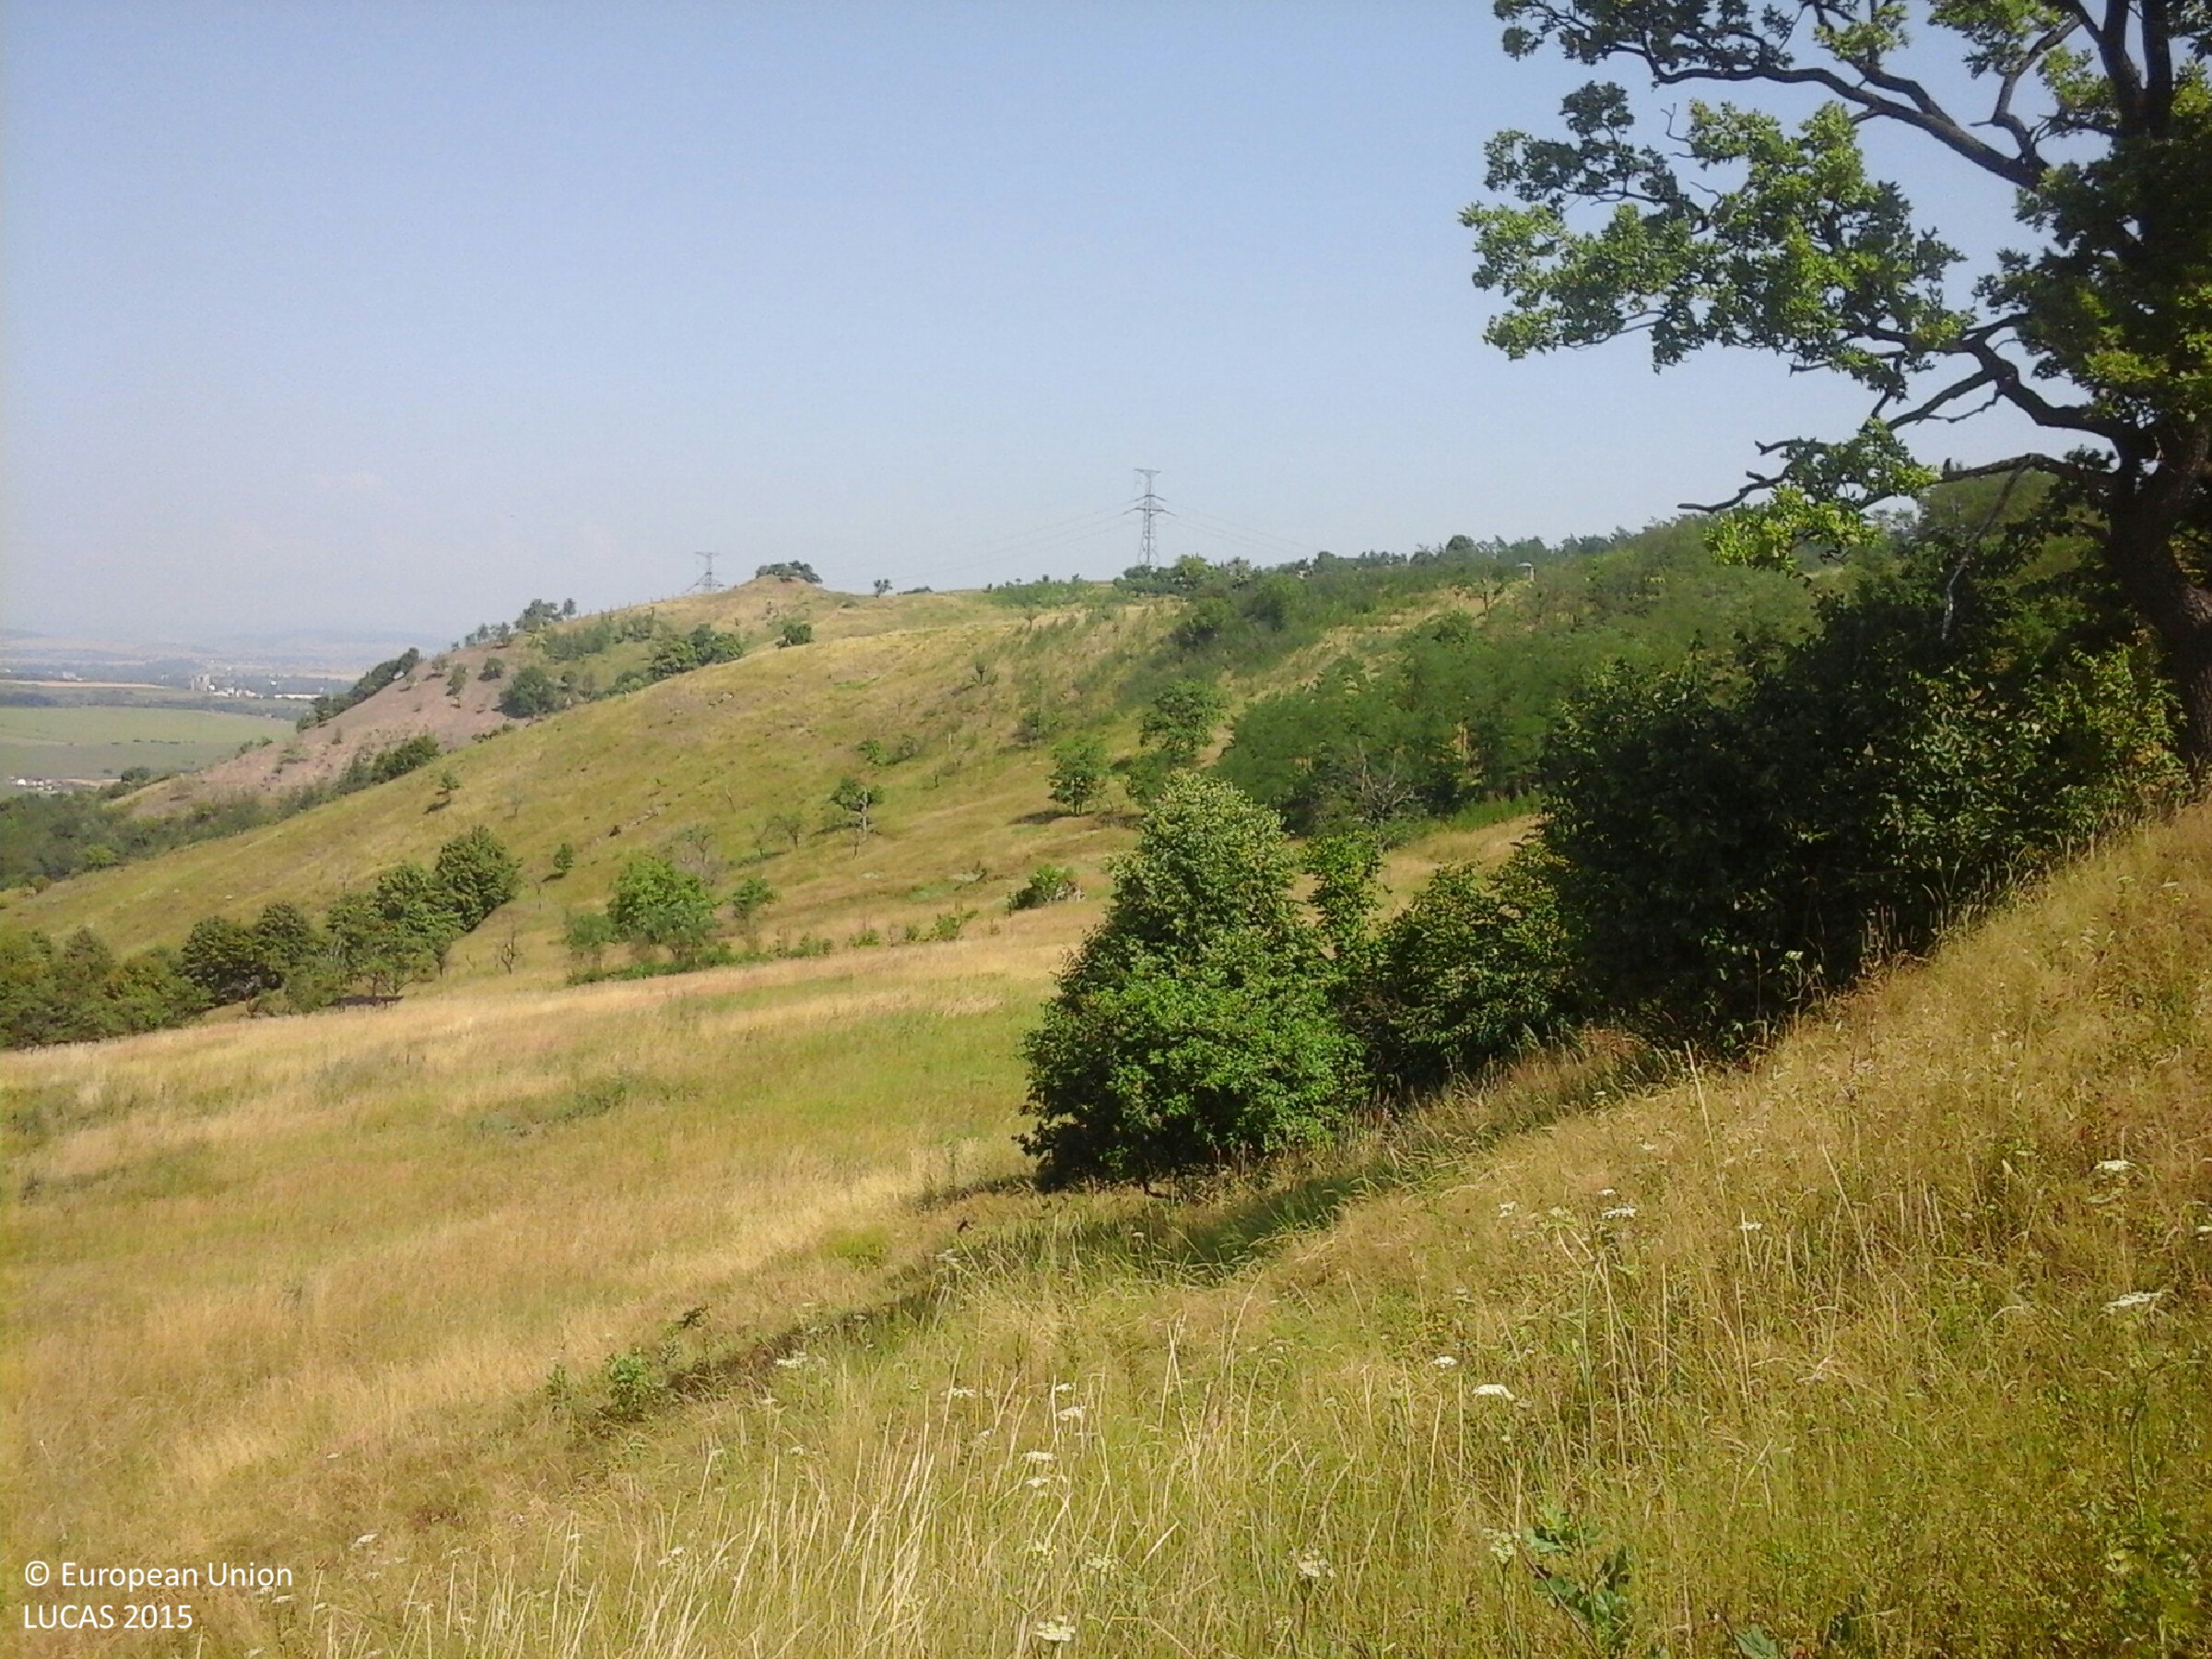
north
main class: Grassland
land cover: Grassland with sparse tree/shrub cover
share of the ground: > 75 %
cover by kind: herbaceous plants 95 %, broadleaved forest trees 5 %
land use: Abandoned areas
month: July
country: HU
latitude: 48.1909
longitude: 20.7037
